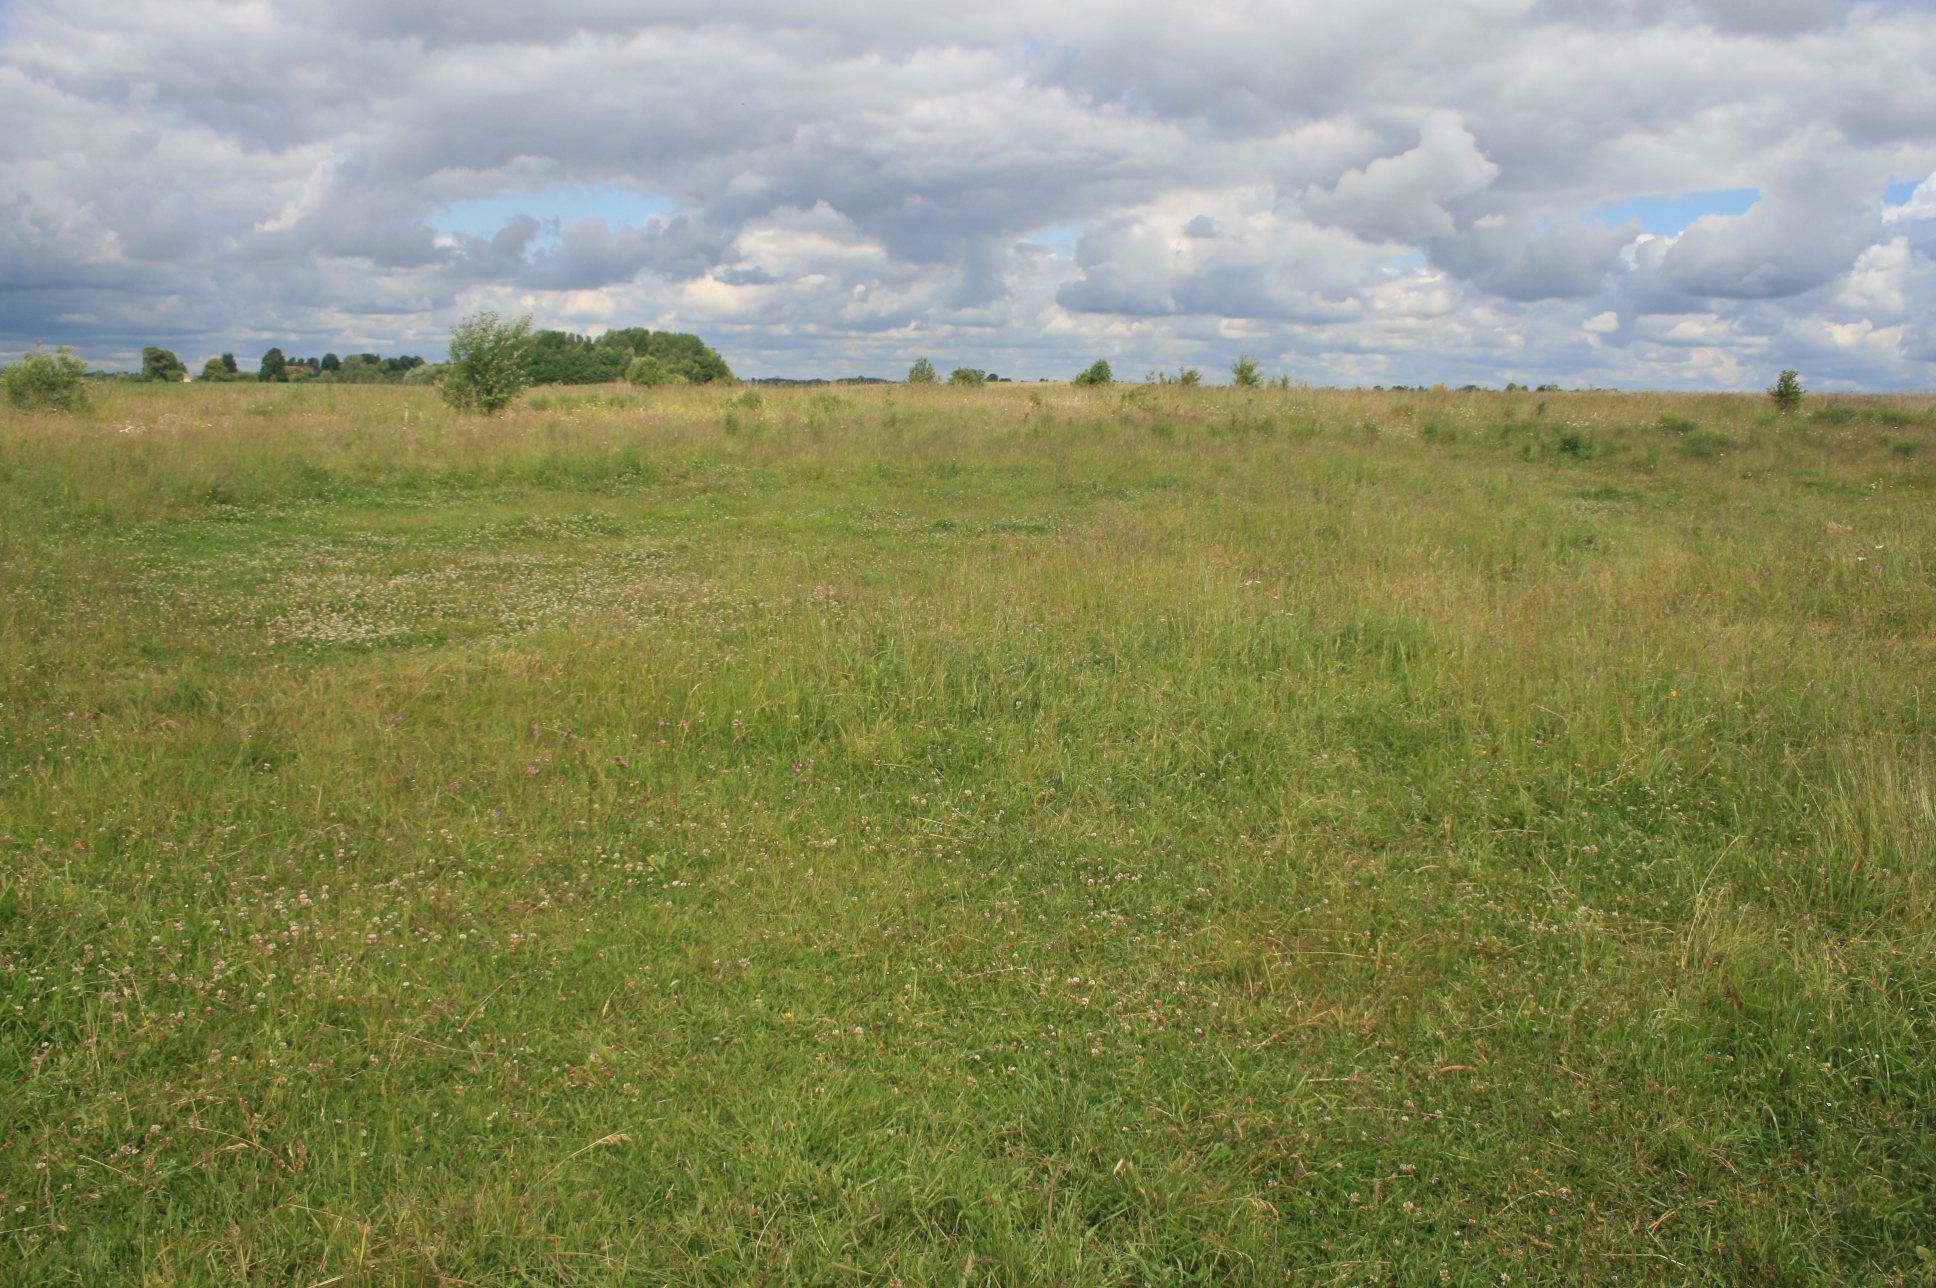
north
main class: Grassland
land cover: Grassland without tree/shrub cover
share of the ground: > 75 %
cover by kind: herbaceous plants 100 %
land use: Agriculture (excluding fallow land and kitchen gardens)
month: June
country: LT
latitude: 55.1966
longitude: 22.0733
